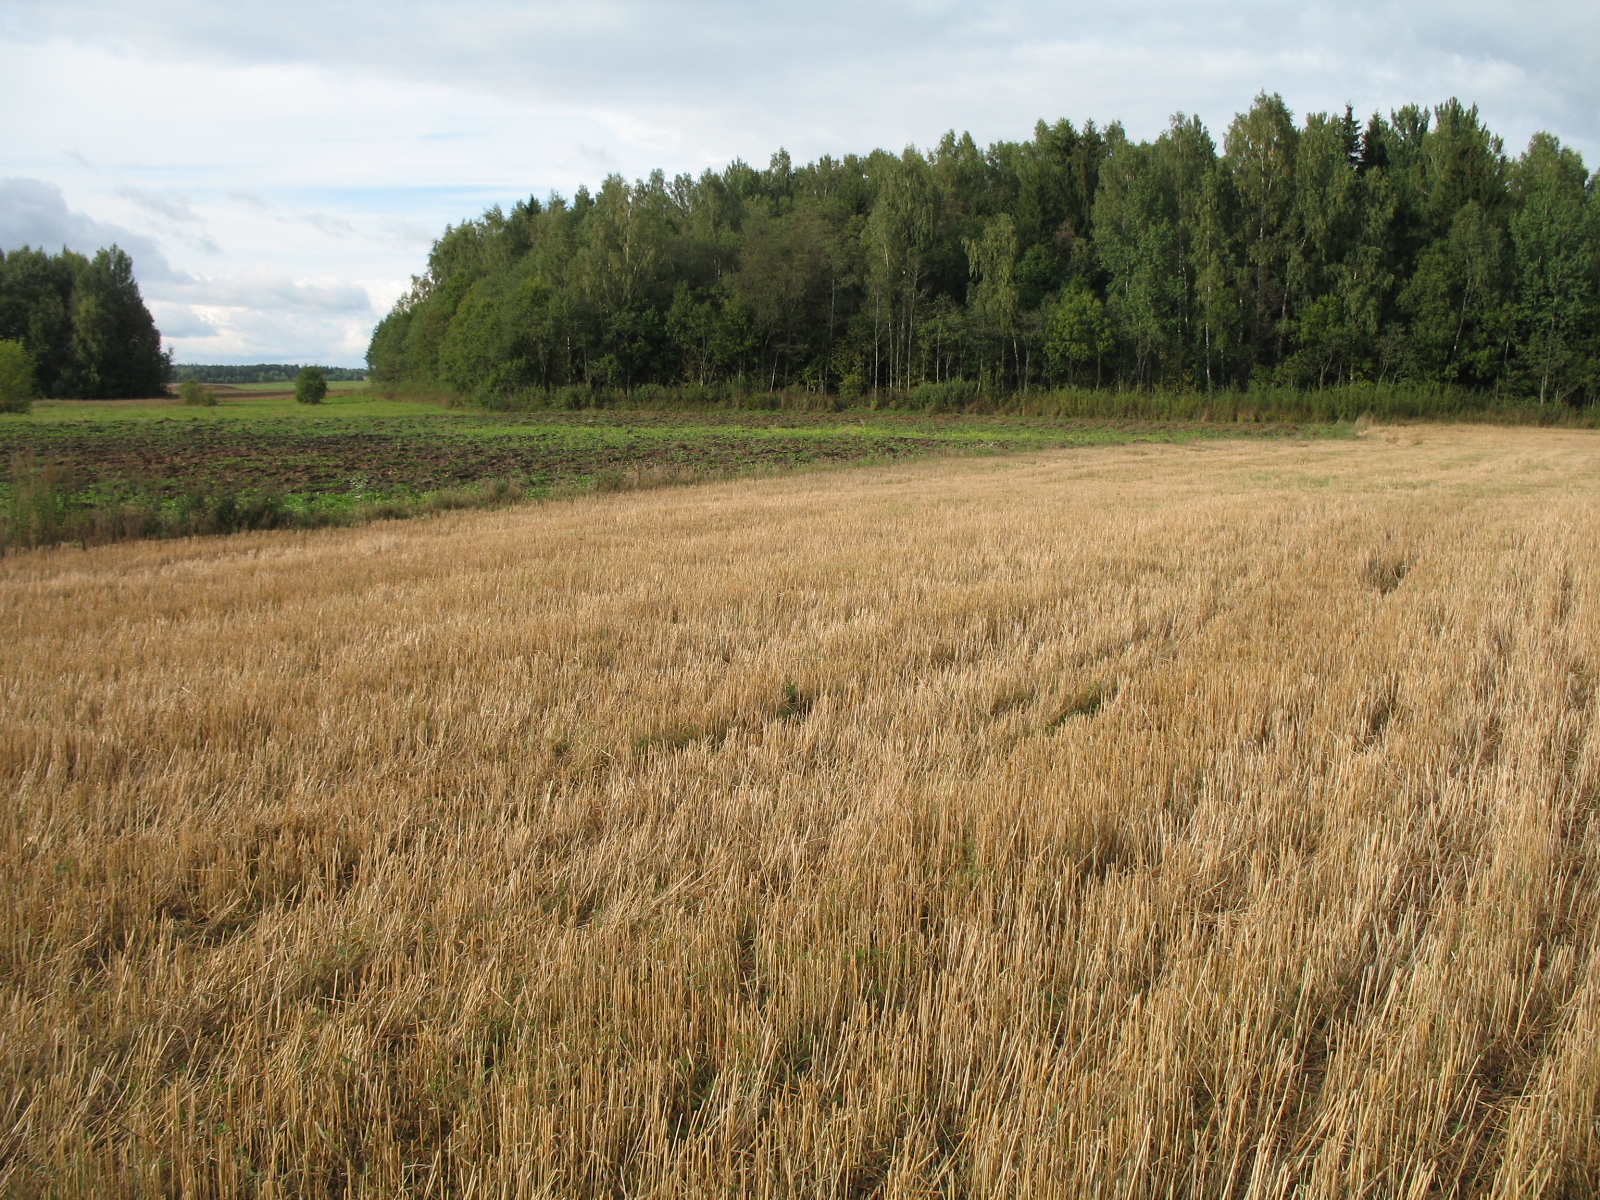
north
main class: Cropland
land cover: Common wheat
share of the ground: 10 - 25 %
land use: Agriculture (excluding fallow land and kitchen gardens)
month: September
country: LV
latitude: 56.0833
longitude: 25.9297
